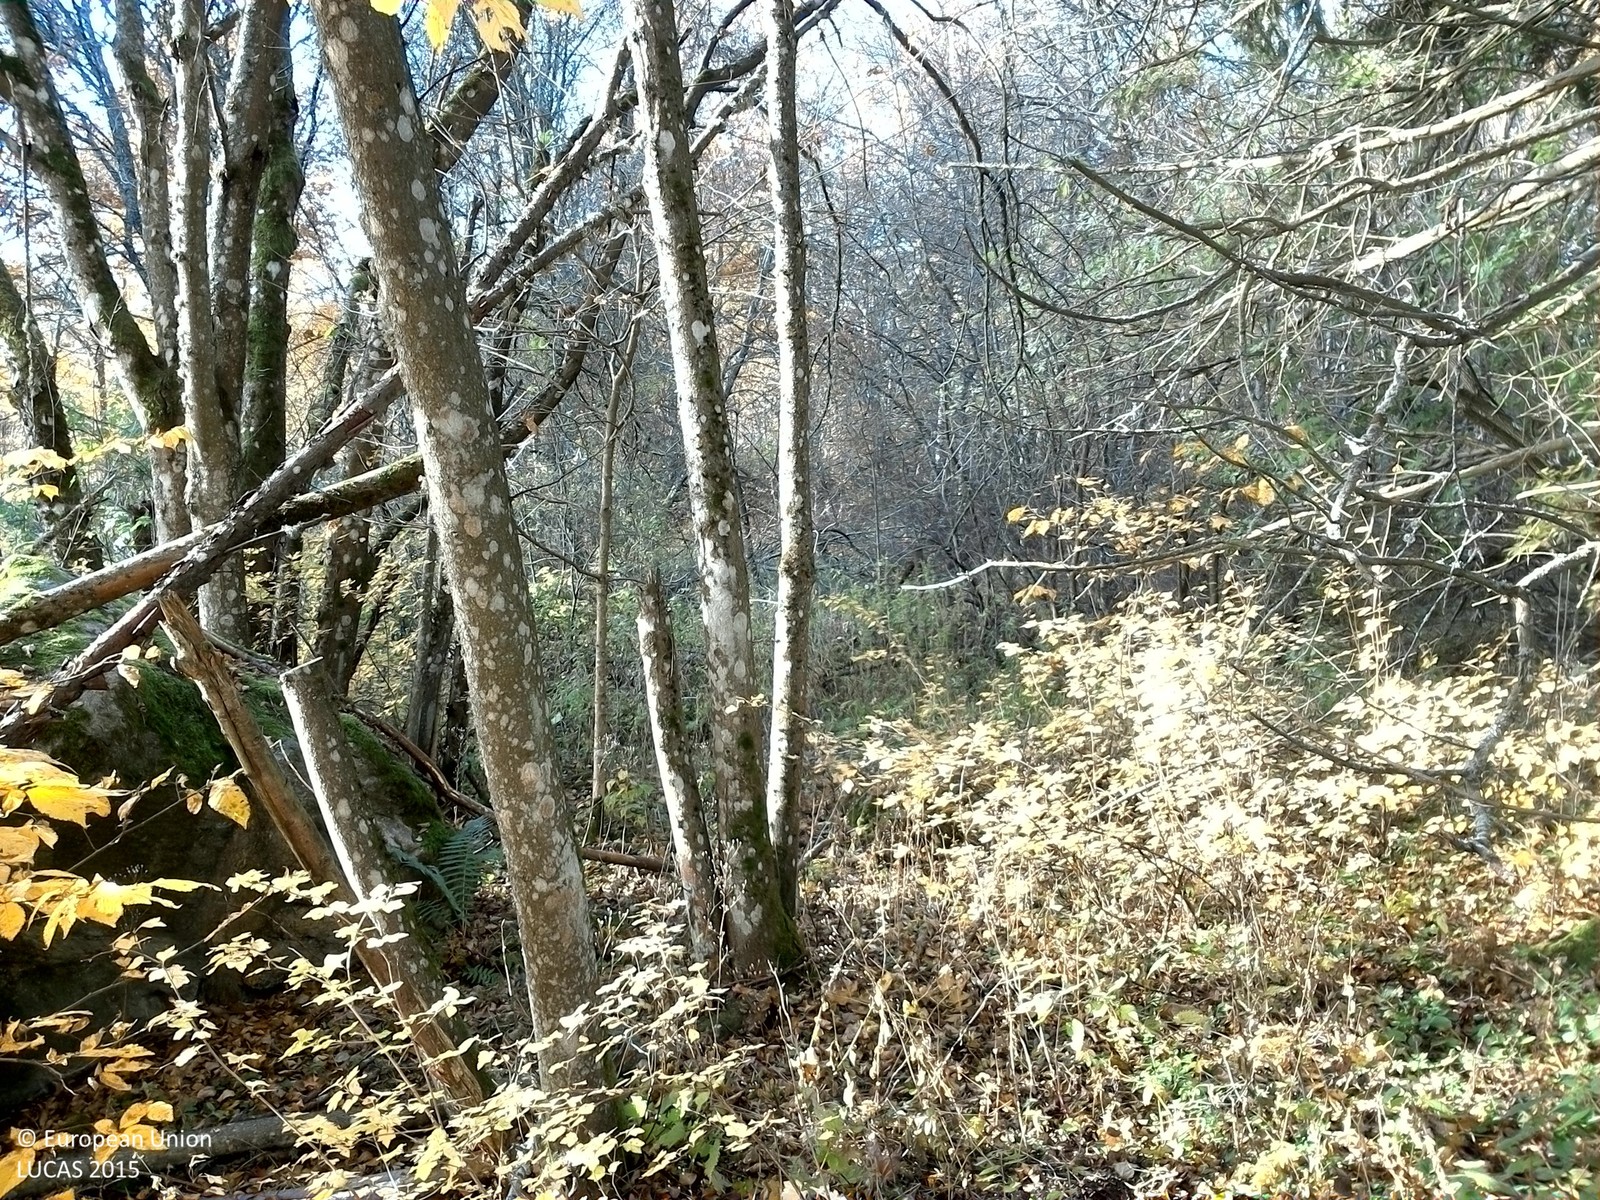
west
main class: Woodland
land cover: Broadleaved woodland
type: hemiboreal forest and nemoral coniferous forest and mixed broadleaved-coniferous forest
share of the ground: > 75 %
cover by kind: broadleaved forest trees 75 %, shrubs 10 %, herbaceous plants 10 %, consolidated bare surface 5 %
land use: Forestry
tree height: > 5 m
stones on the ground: < 10 %
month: October
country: SE
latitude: 59.4428
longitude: 16.3231
